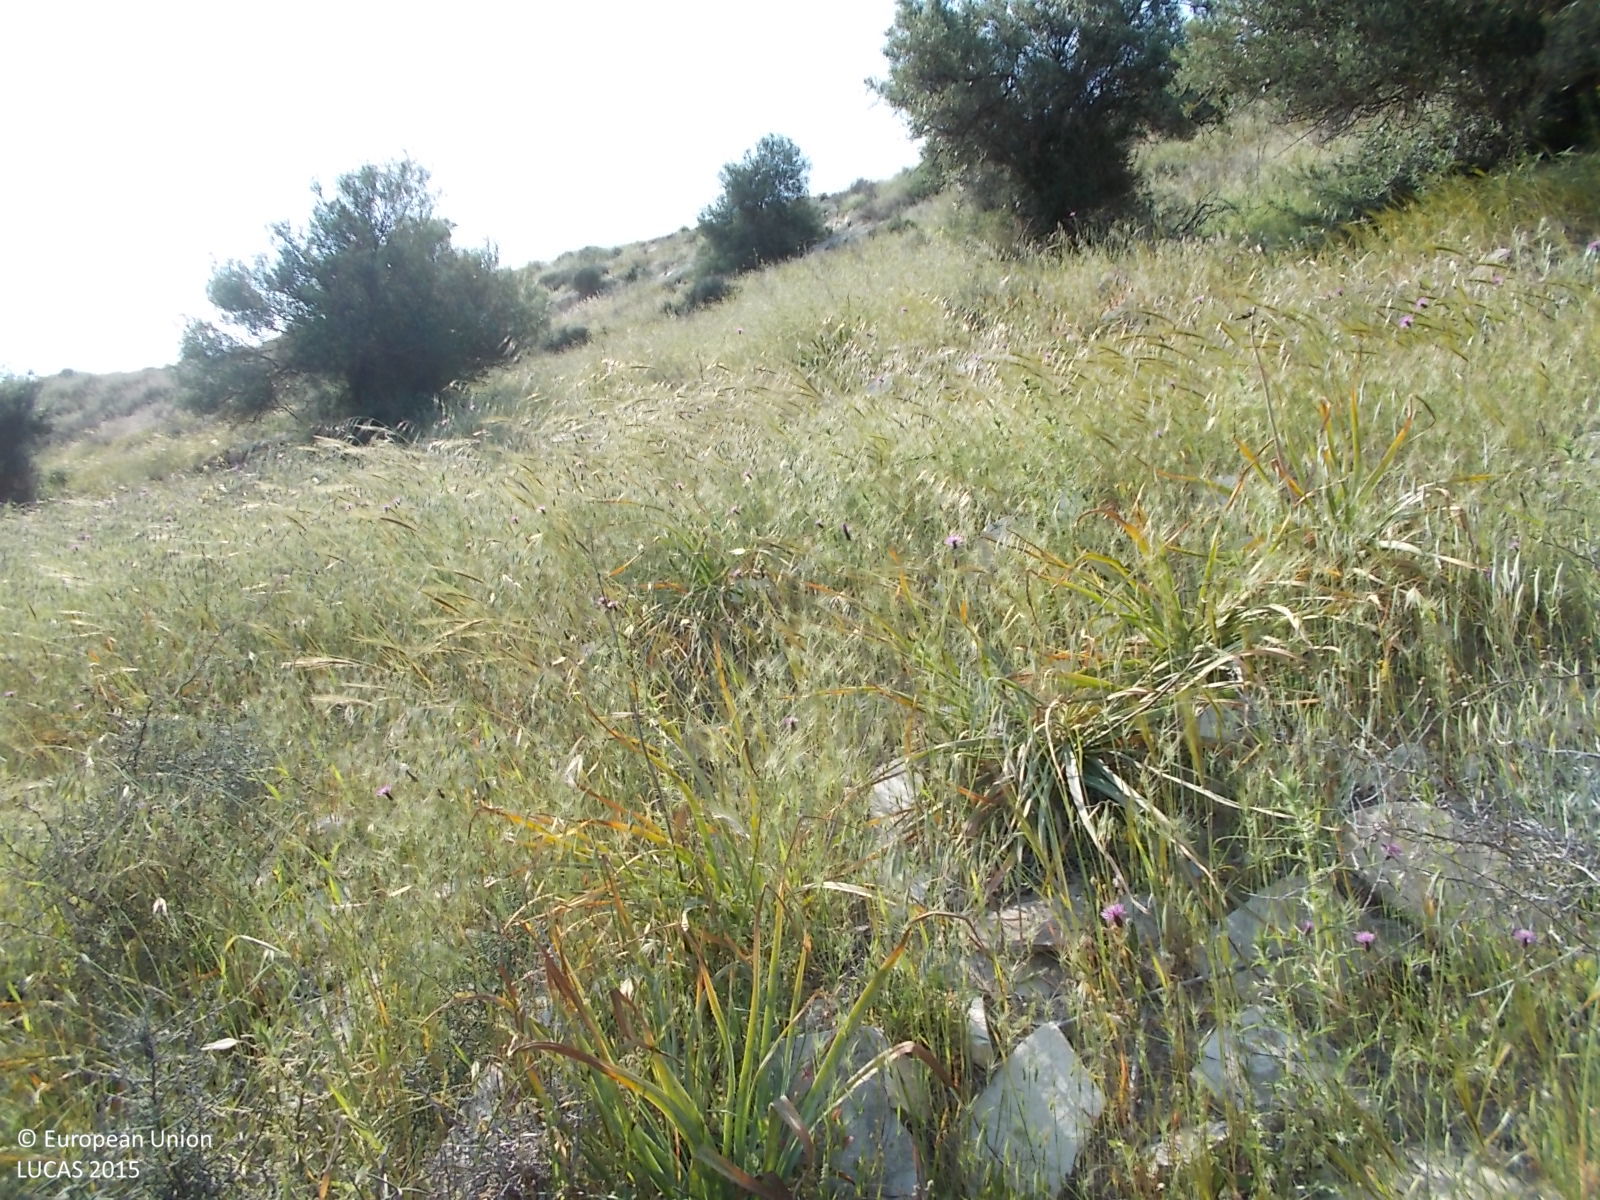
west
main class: Cropland
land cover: Olive groves
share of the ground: 25 - 50 %
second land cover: Grassland without tree/shrub cover
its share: > 75 %
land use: Abandoned areas
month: April
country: CY
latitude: 34.9507
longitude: 33.4826
